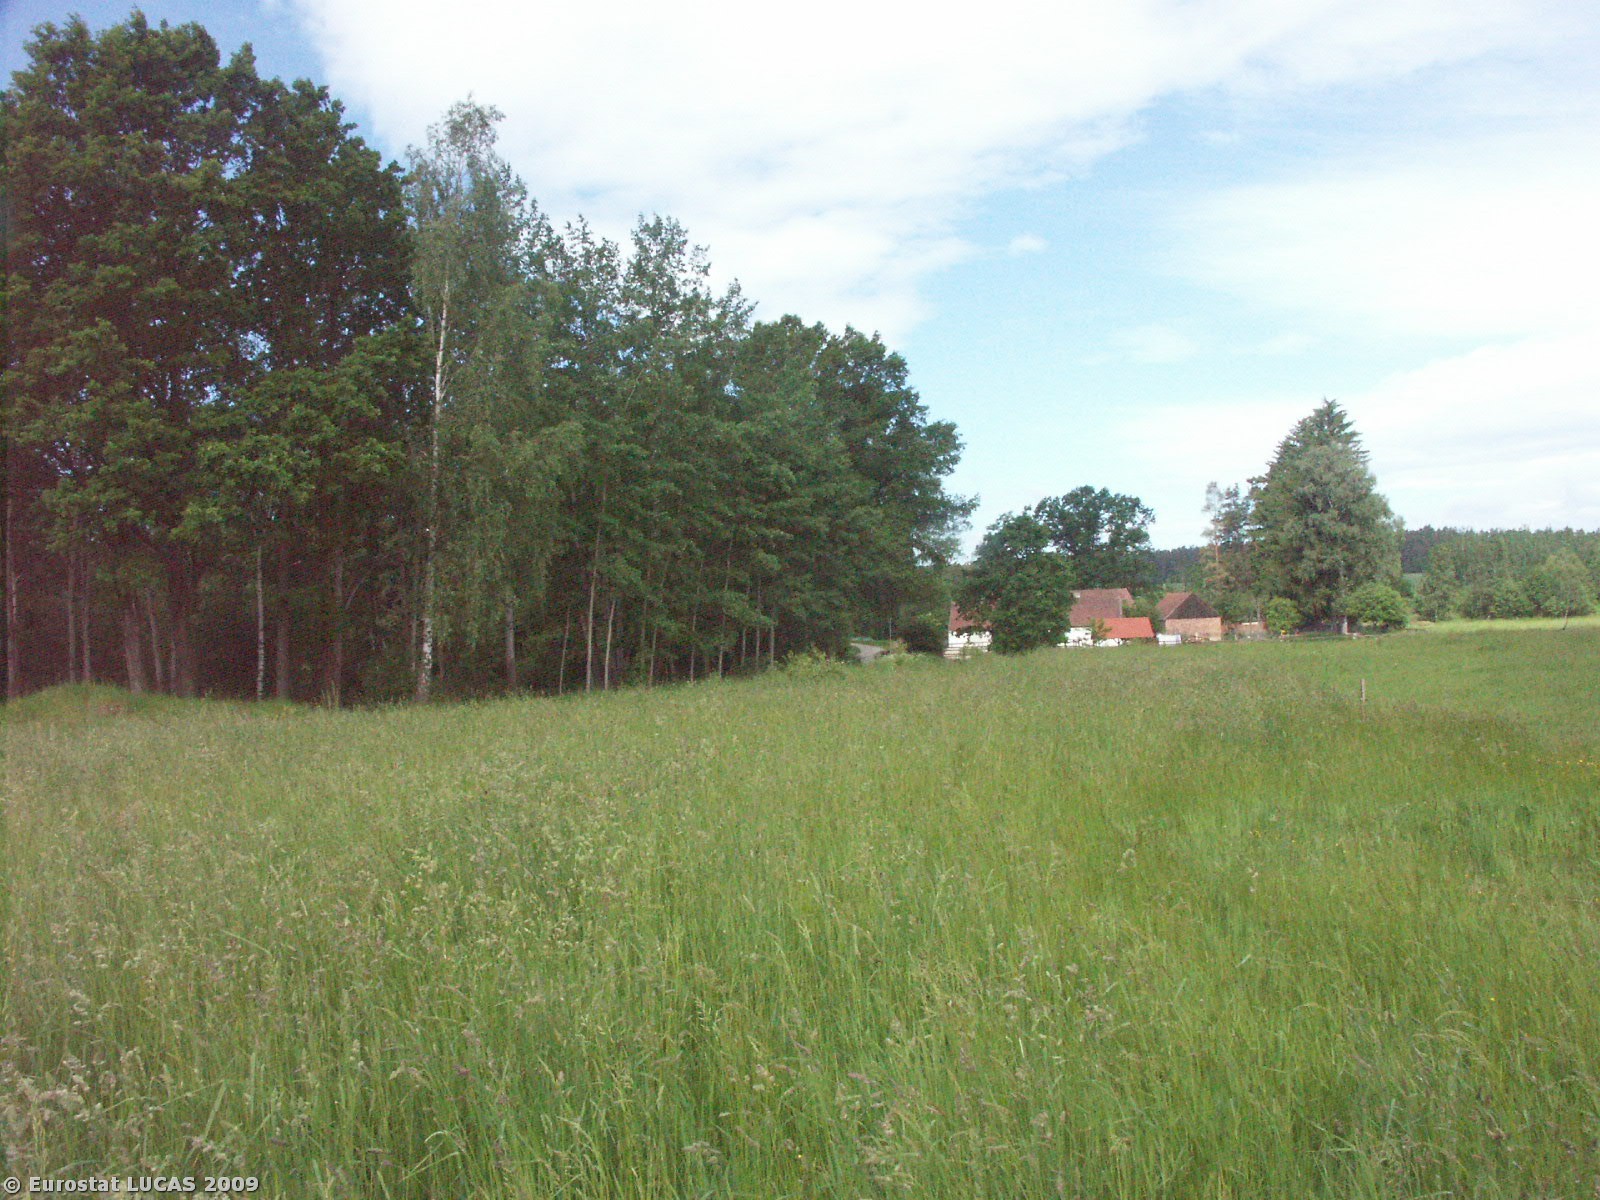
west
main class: Grassland
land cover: Grassland without tree/shrub cover
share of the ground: > 75 %
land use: Agriculture (excluding fallow land and kitchen gardens)
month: May
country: CZ
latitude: 48.9350
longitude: 14.6837
